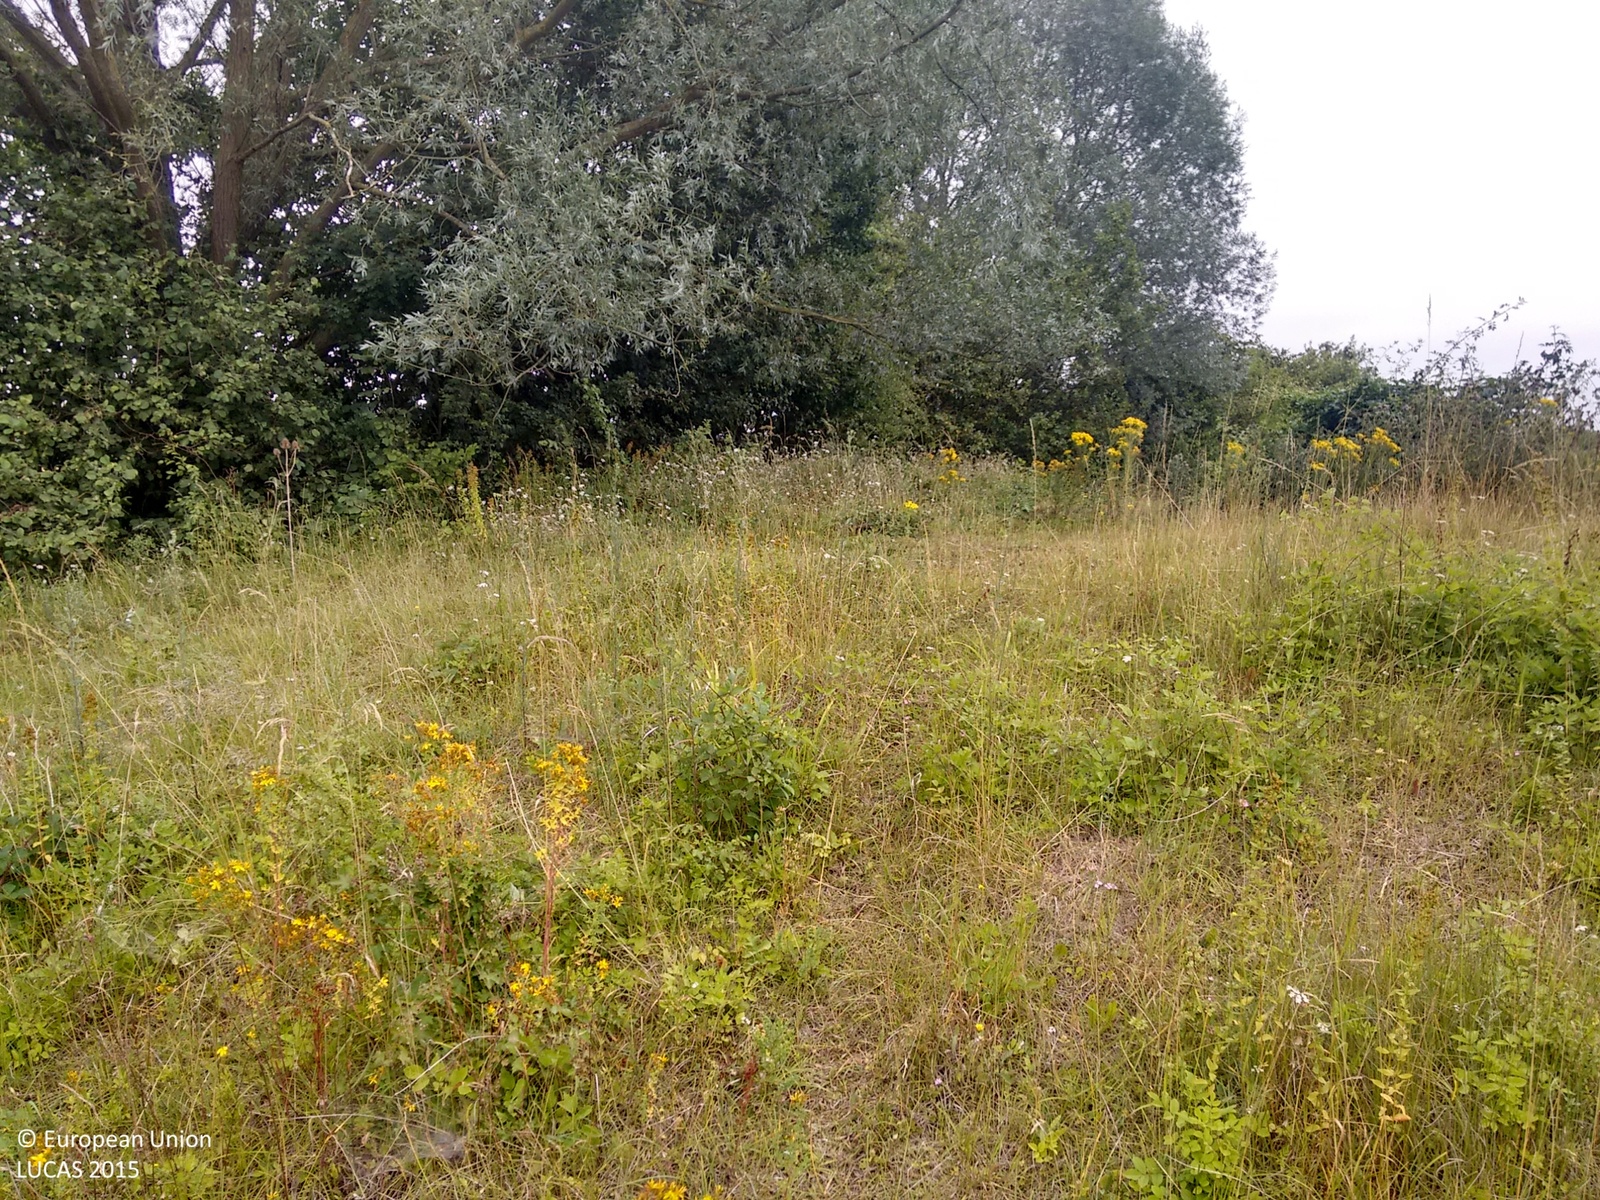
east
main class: Grassland
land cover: Grassland without tree/shrub cover
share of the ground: > 75 %
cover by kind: herbaceous plants 100 %
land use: Semi-natural and natural areas not in use
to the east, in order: Grassland without tree/shrub cover; Abandoned hedges; Ditches and canals; Grass margins; Common wheat; Electric lines; Common wheat; Grassland without tree/shrub cover; Artificial constructions in urban areas; Broadleaved woodland
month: July
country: GB
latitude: 51.8135
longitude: 0.2657
